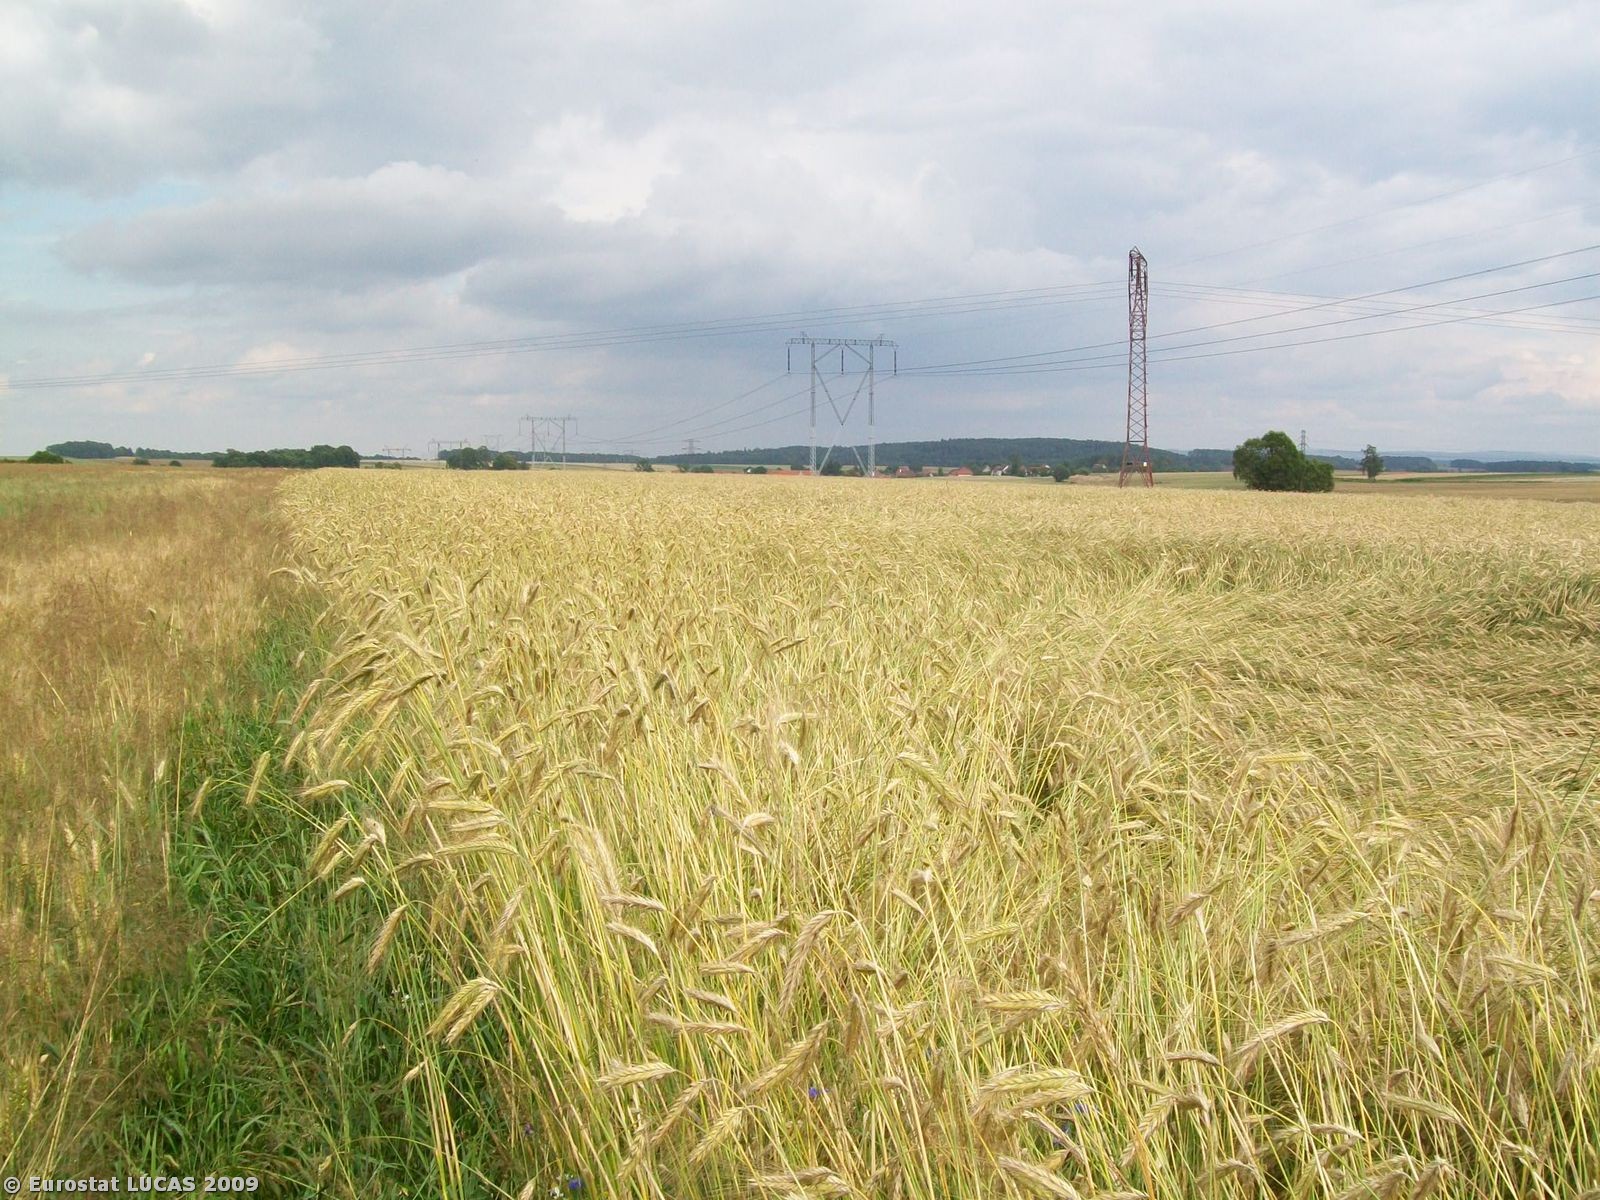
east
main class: Cropland
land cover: Triticale
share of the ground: > 75 %
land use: Agriculture (excluding fallow land and kitchen gardens)
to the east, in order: Triticale; Electric lines; Rape and turnip rape; Common wheat
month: July
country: PL
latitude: 51.1304
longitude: 15.1620
